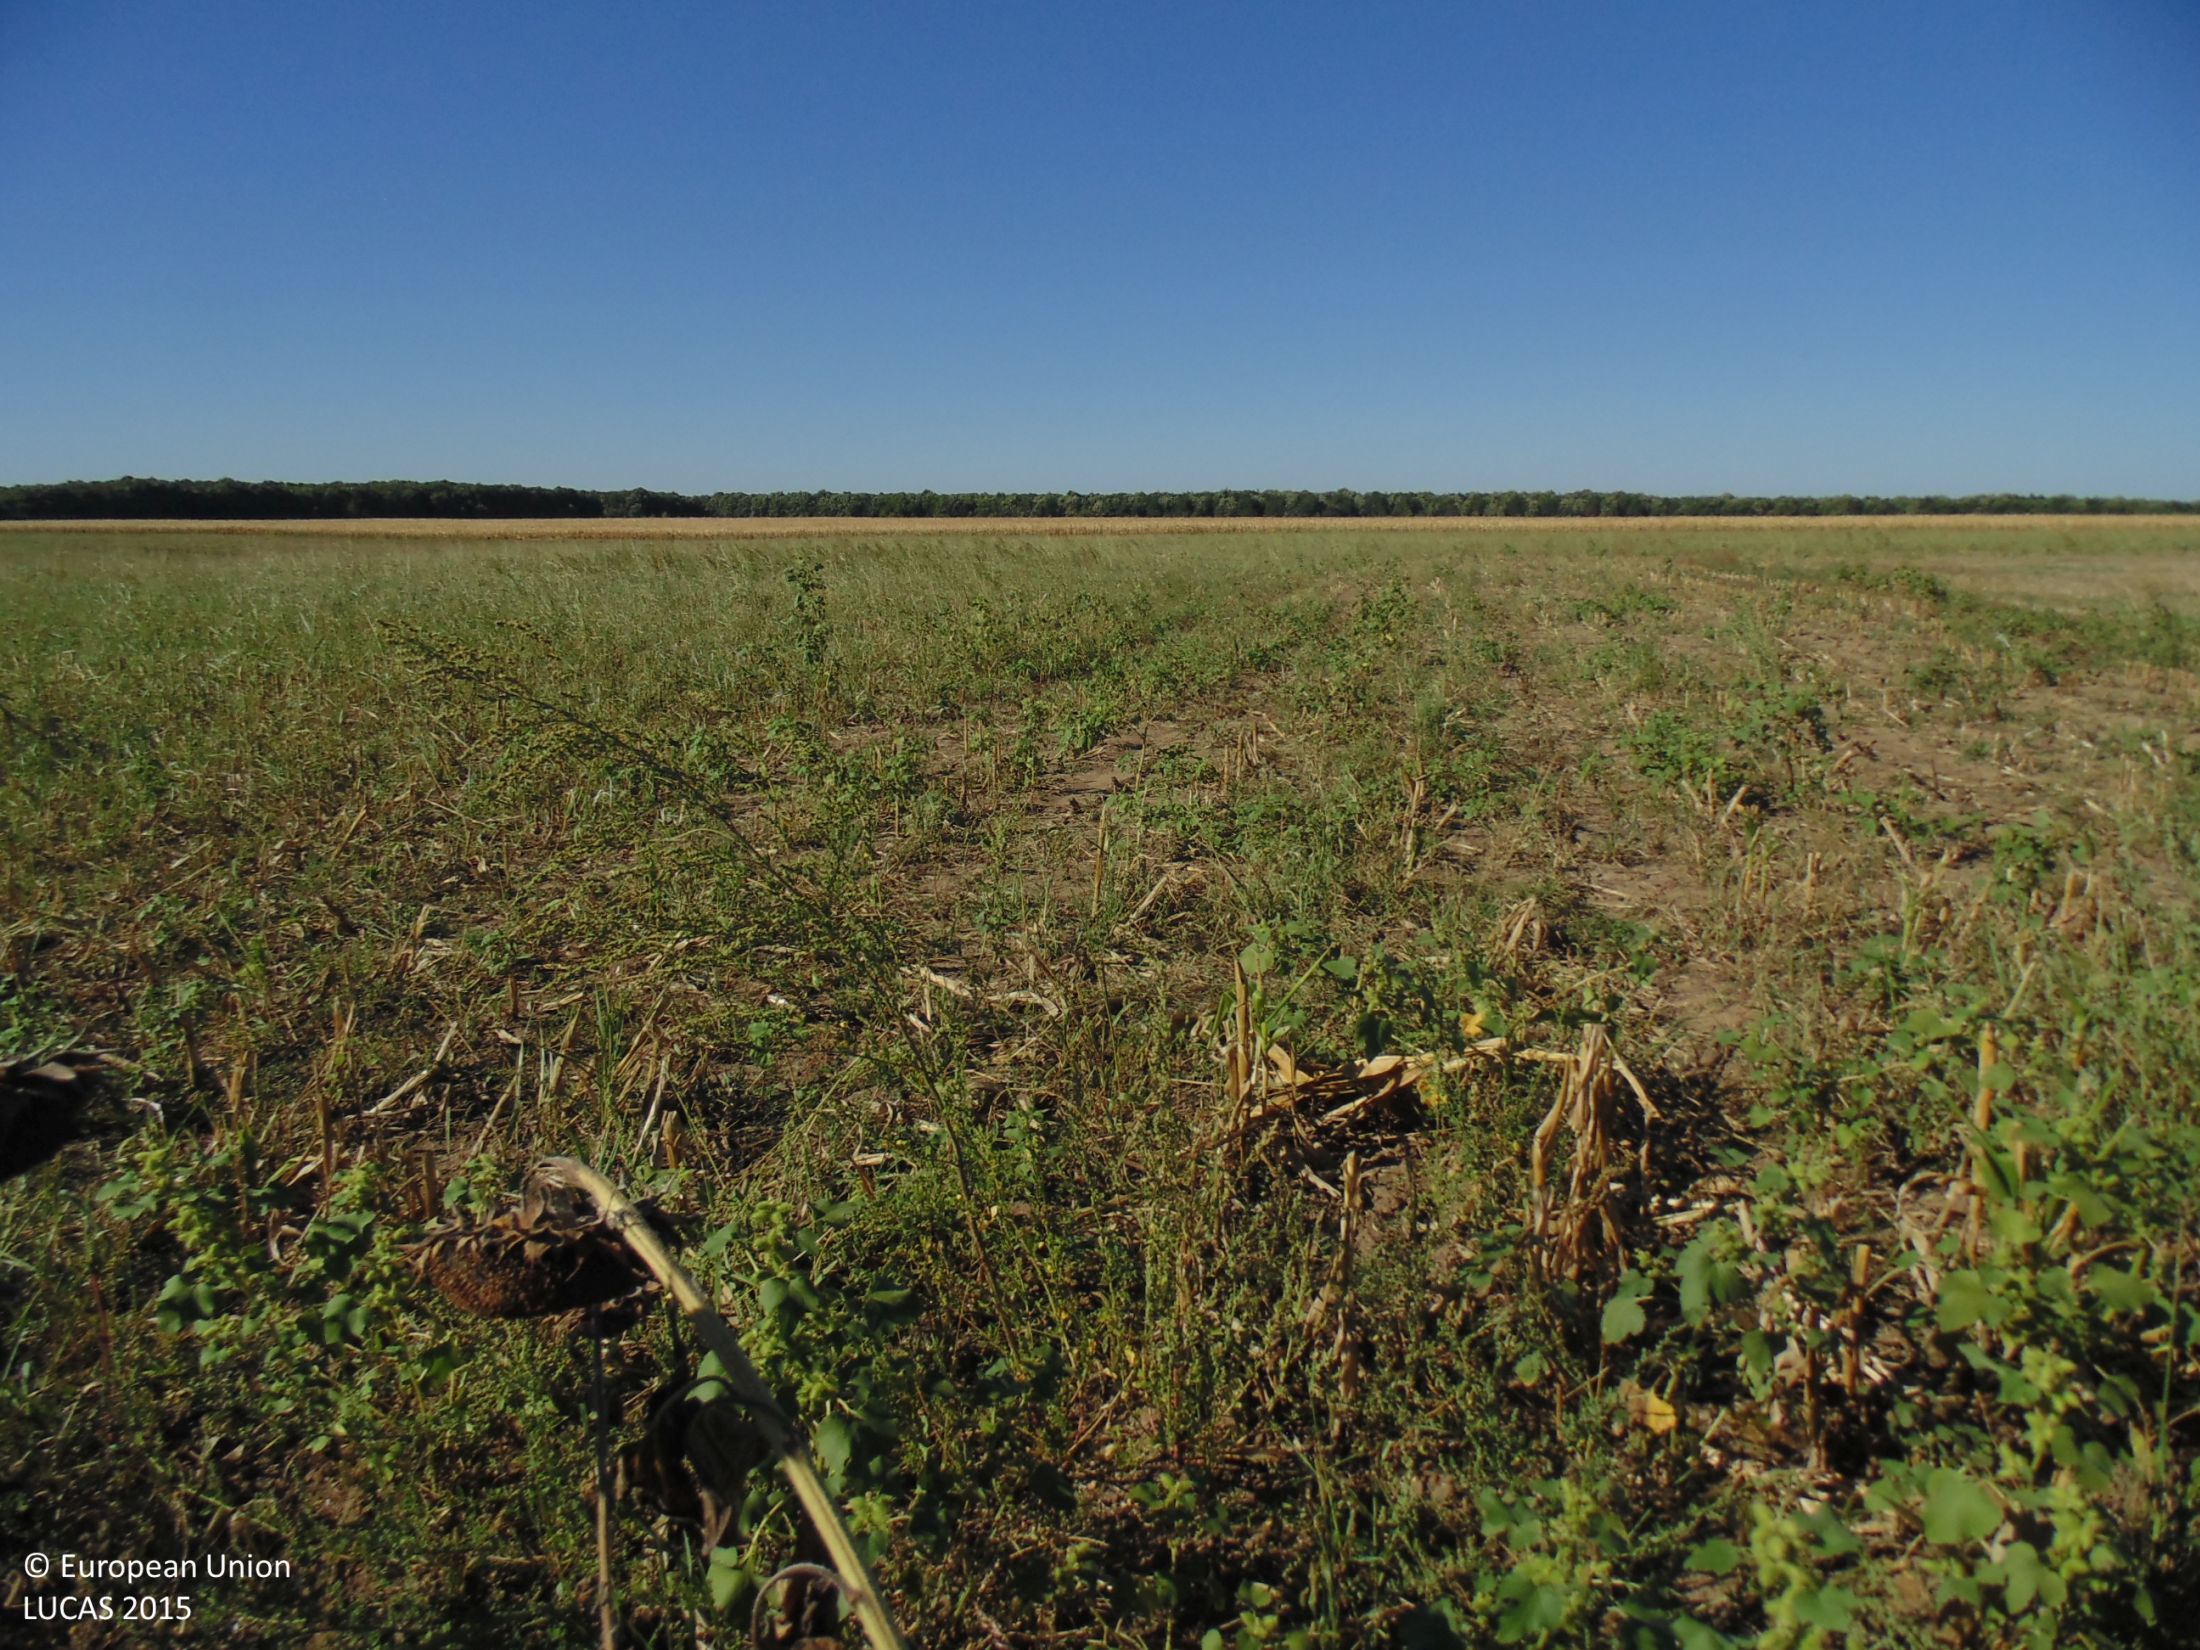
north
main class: Cropland
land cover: Sunflower
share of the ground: > 75 %
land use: Agriculture (excluding fallow land and kitchen gardens)
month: September
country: BG
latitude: 43.8570
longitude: 27.2088
